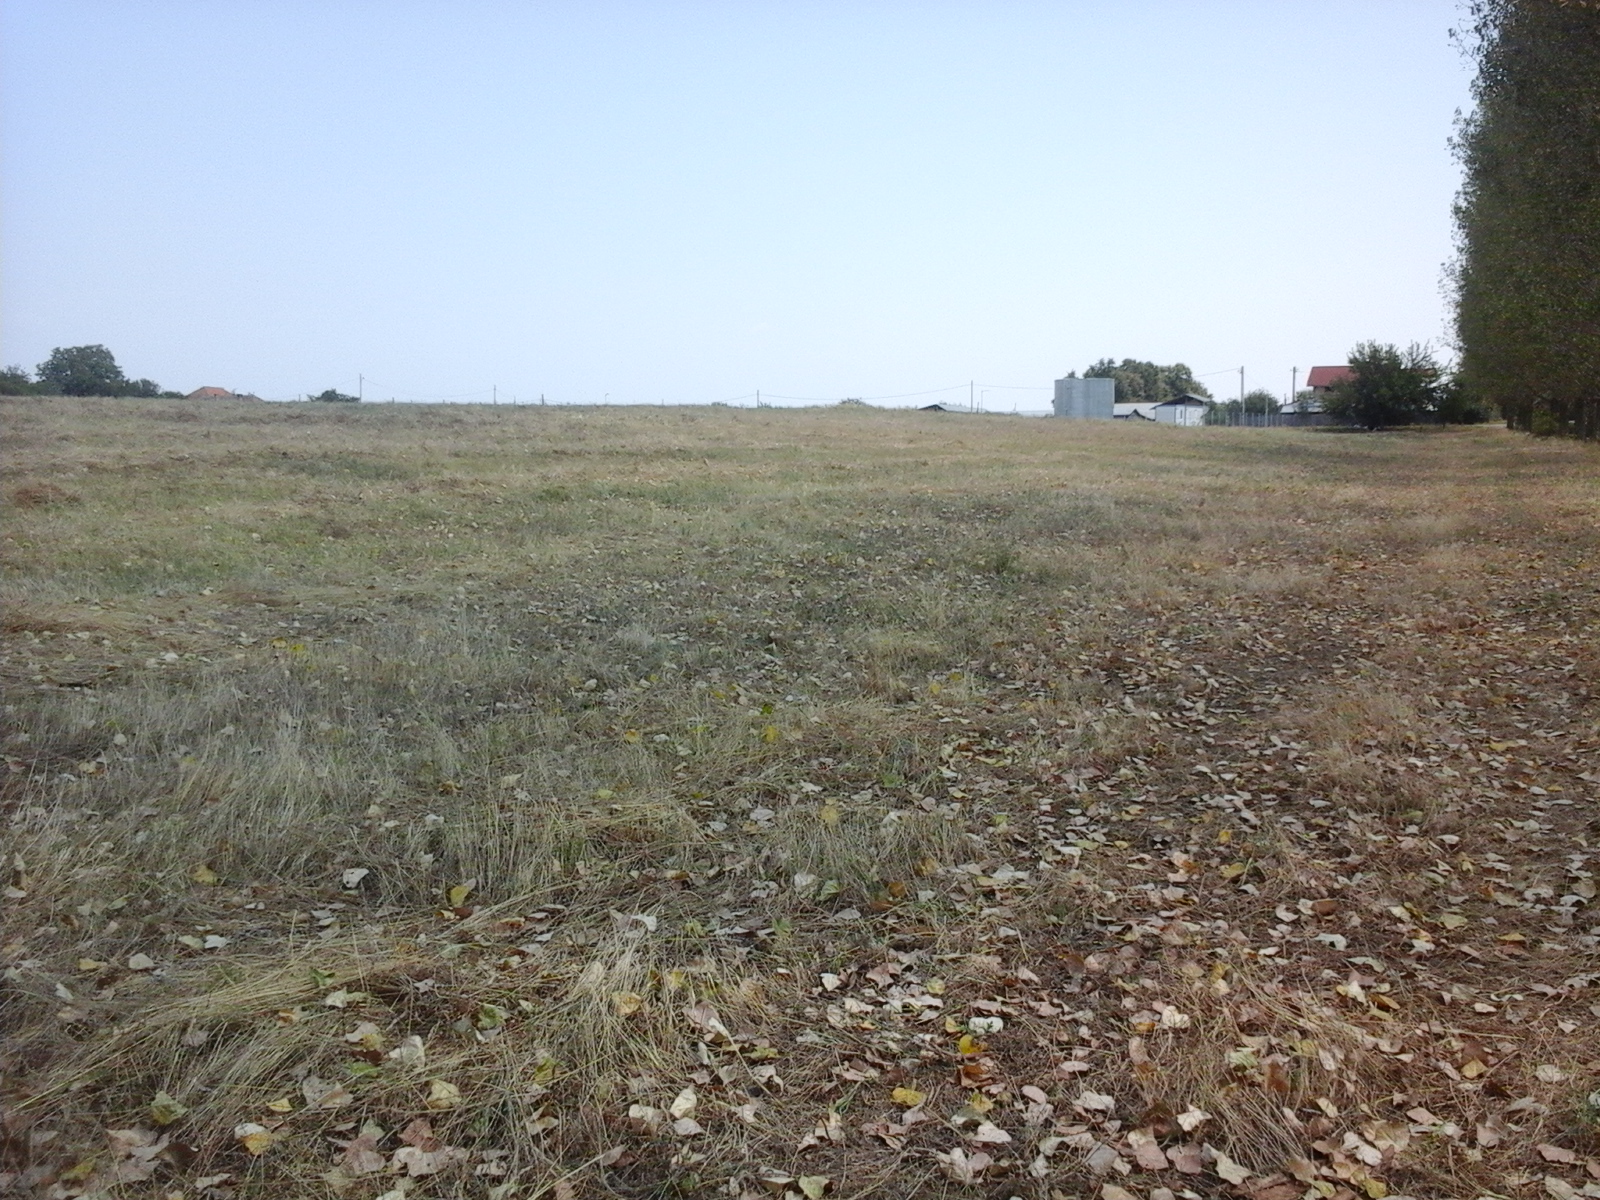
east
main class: Grassland
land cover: Grassland without tree/shrub cover
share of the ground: > 75 %
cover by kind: herbaceous plants 100 %
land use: Agriculture (excluding fallow land and kitchen gardens)
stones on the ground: < 10 %
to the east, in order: Grassland without tree/shrub cover; Tracks; Grassland without tree/shrub cover; Tracks; Grassland without tree/shrub cover
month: August
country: RO
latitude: 44.5200
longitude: 22.6597
